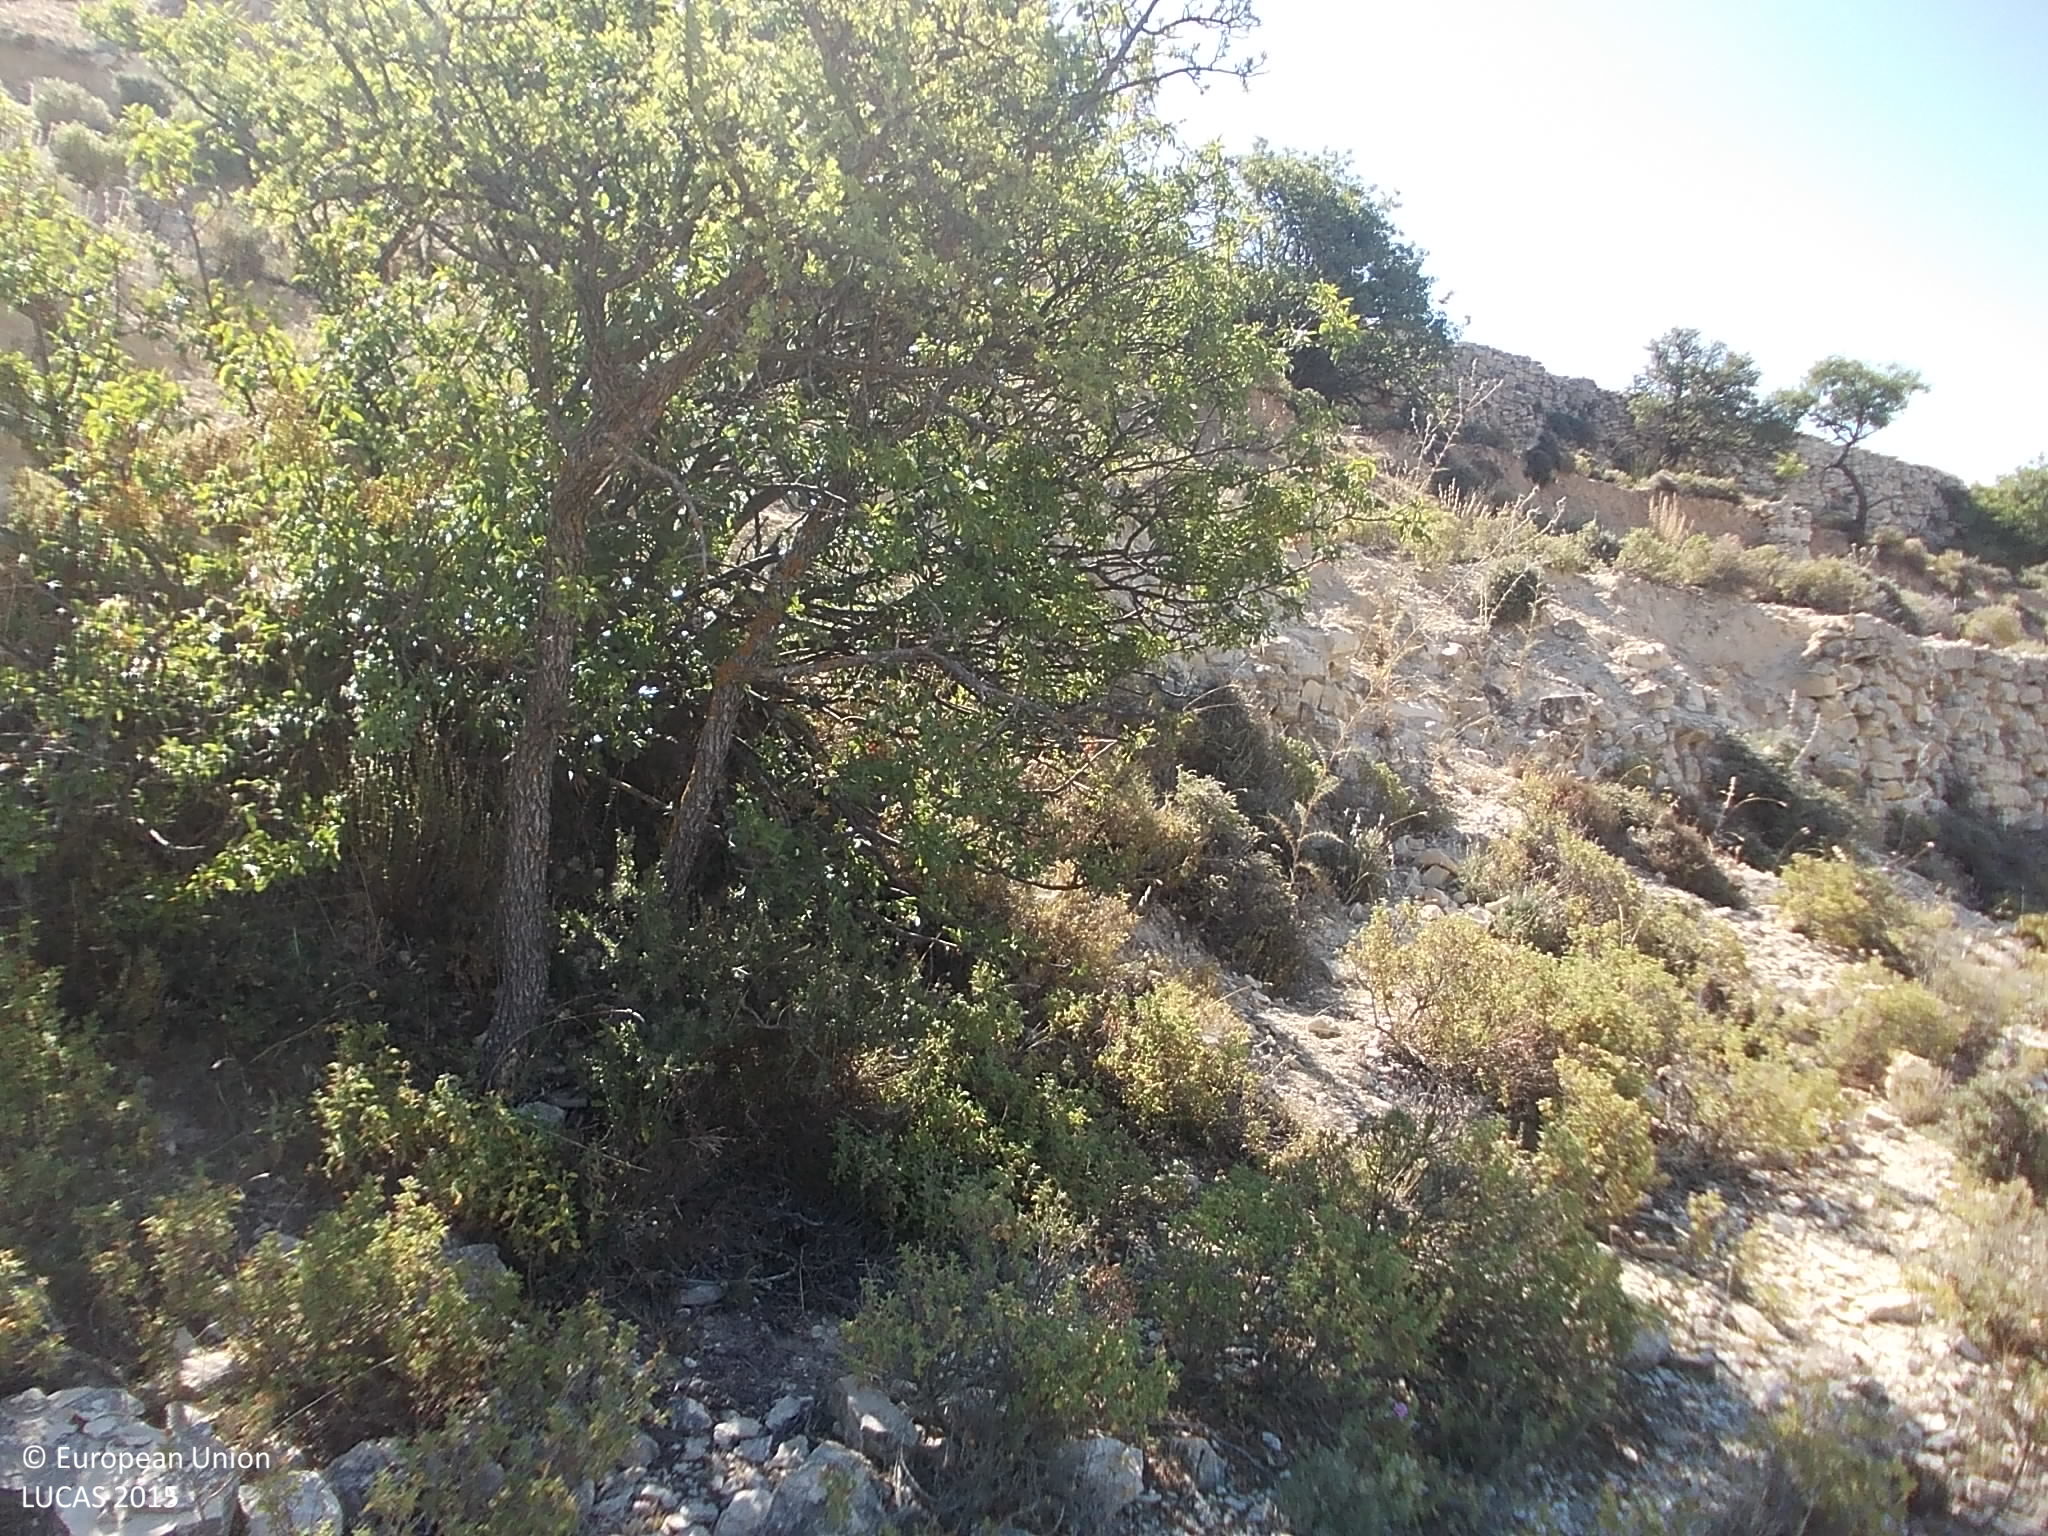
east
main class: Shrubland
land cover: Shrubland with sparse tree cover
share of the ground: > 75 %
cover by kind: shrubs 70 %, herbaceous plants 10 %, unconsolidated bare surface 10 %, broadleaved forest trees 5 %, consolidated bare surface 5 %
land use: Semi-natural and natural areas not in use
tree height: < 5 m
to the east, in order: Shrubland with sparse tree cover; Dry stone walls; Shrubland with sparse tree cover; Dry stone walls; Shrubland with sparse tree cover; Dry stone walls; Shrubland with sparse tree cover; Dry stone walls; Shrubland with sparse tree cover; Dry stone walls; Grassland without tree/shrub cover; Tracks; Grassland without tree/shrub cover; Dry stone walls; Lines of trees; Shrubland with sparse tree cover; Dry stone walls; Shrubland without tree cover
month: July
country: CY
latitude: 34.8092
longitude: 32.8669
